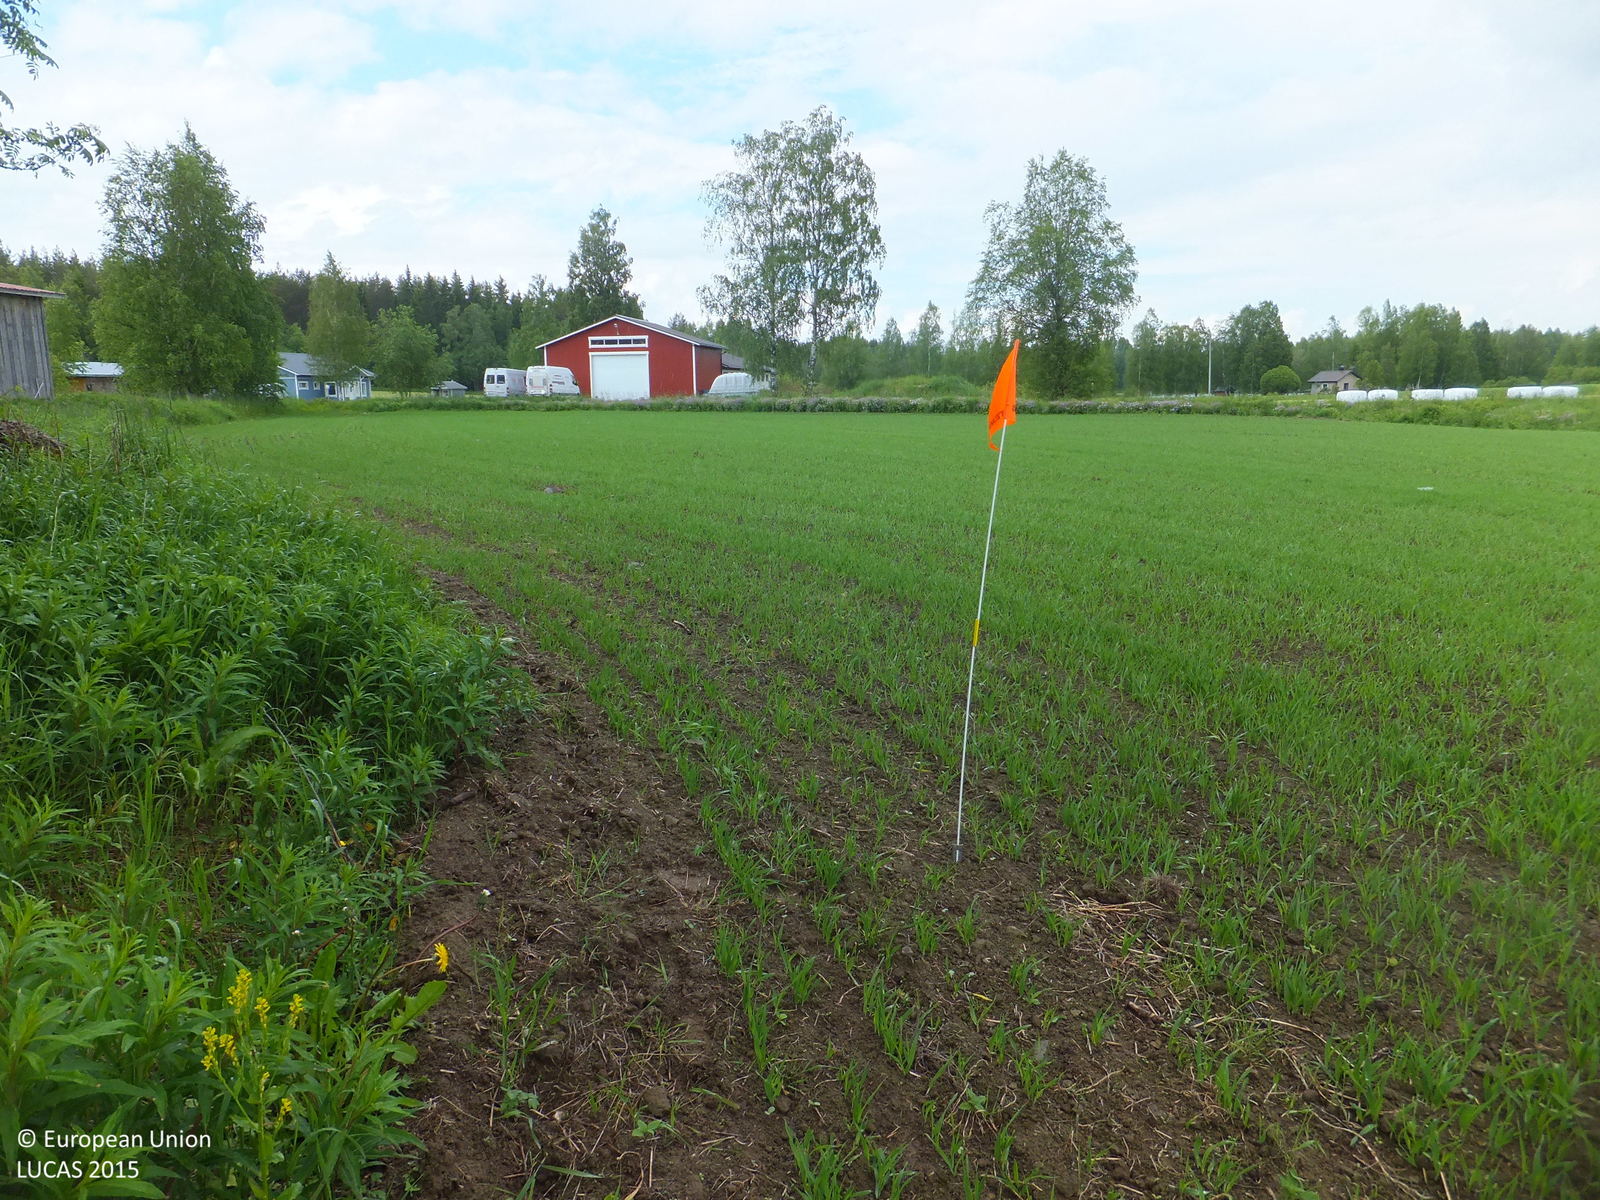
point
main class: Cropland
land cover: Barley
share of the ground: > 75 %
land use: Agriculture (excluding fallow land and kitchen gardens)
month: June
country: FI
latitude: 63.6165
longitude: 25.0769
